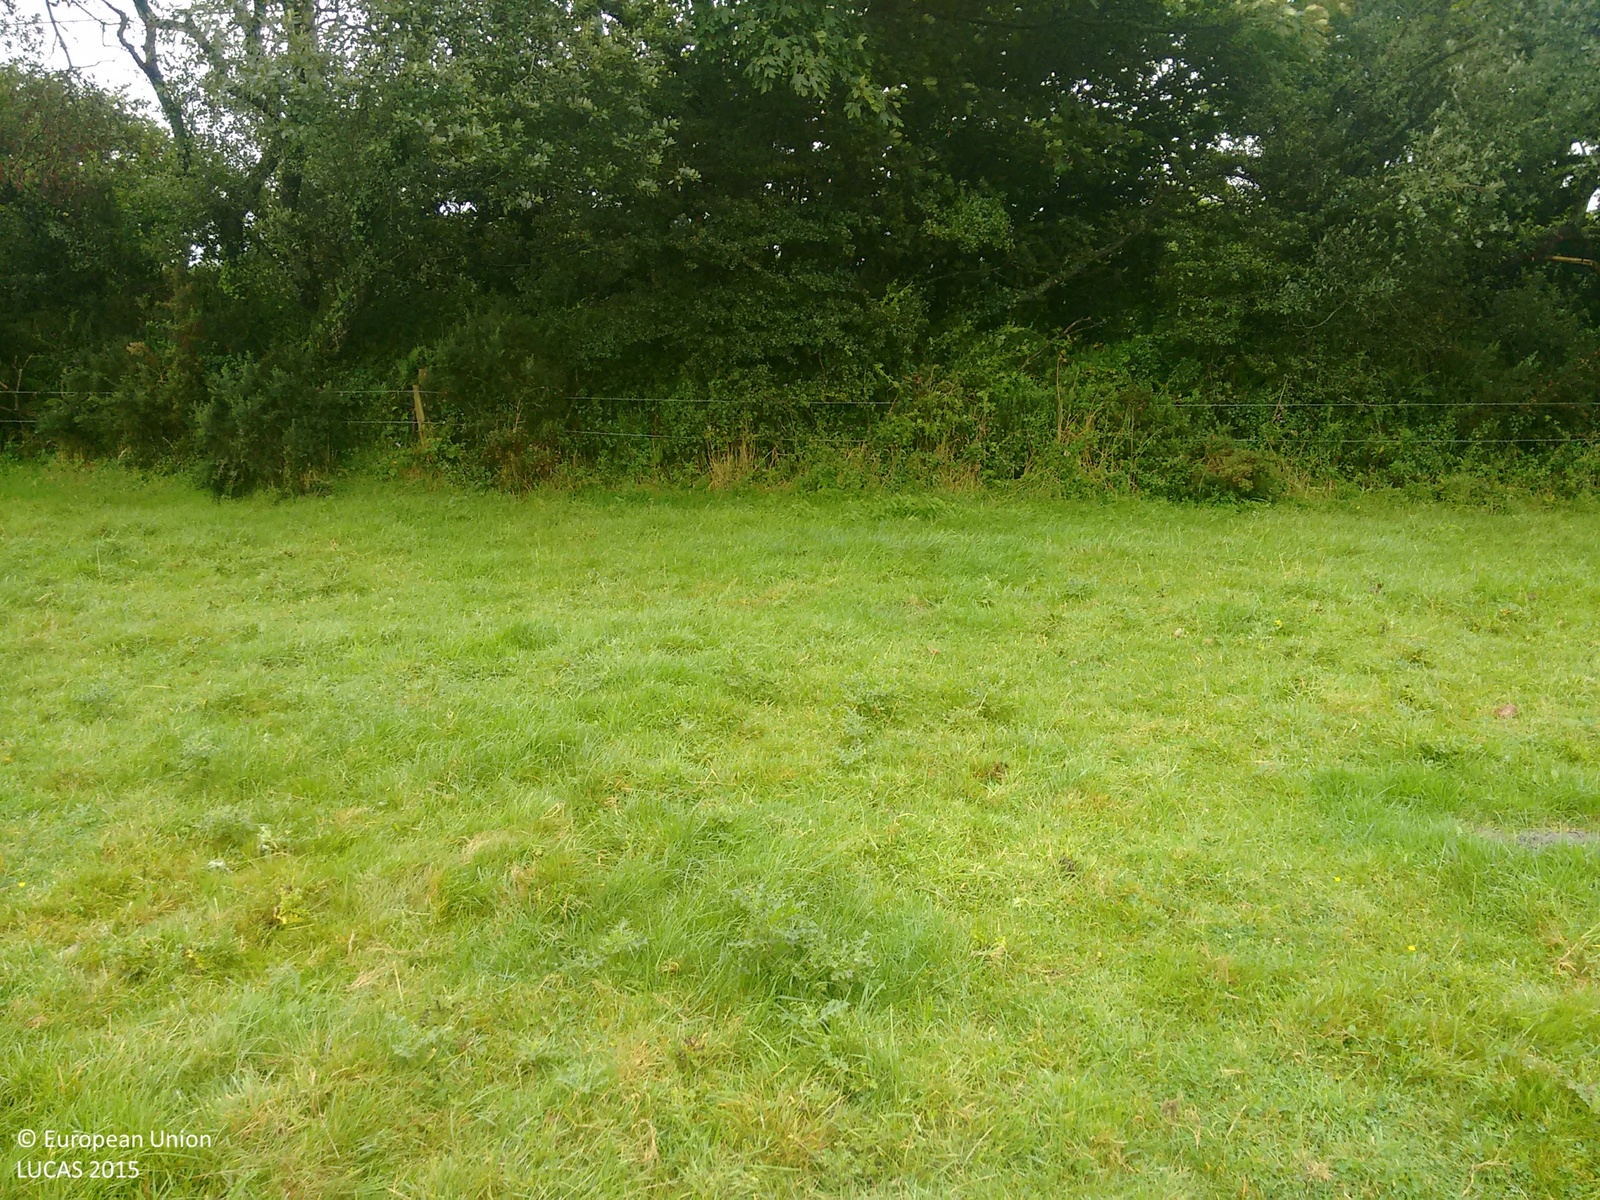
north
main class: Grassland
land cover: Grassland without tree/shrub cover
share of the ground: > 75 %
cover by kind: herbaceous plants 100 %
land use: Agriculture (excluding fallow land and kitchen gardens)
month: August
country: GB
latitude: 50.0803
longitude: -5.1411
